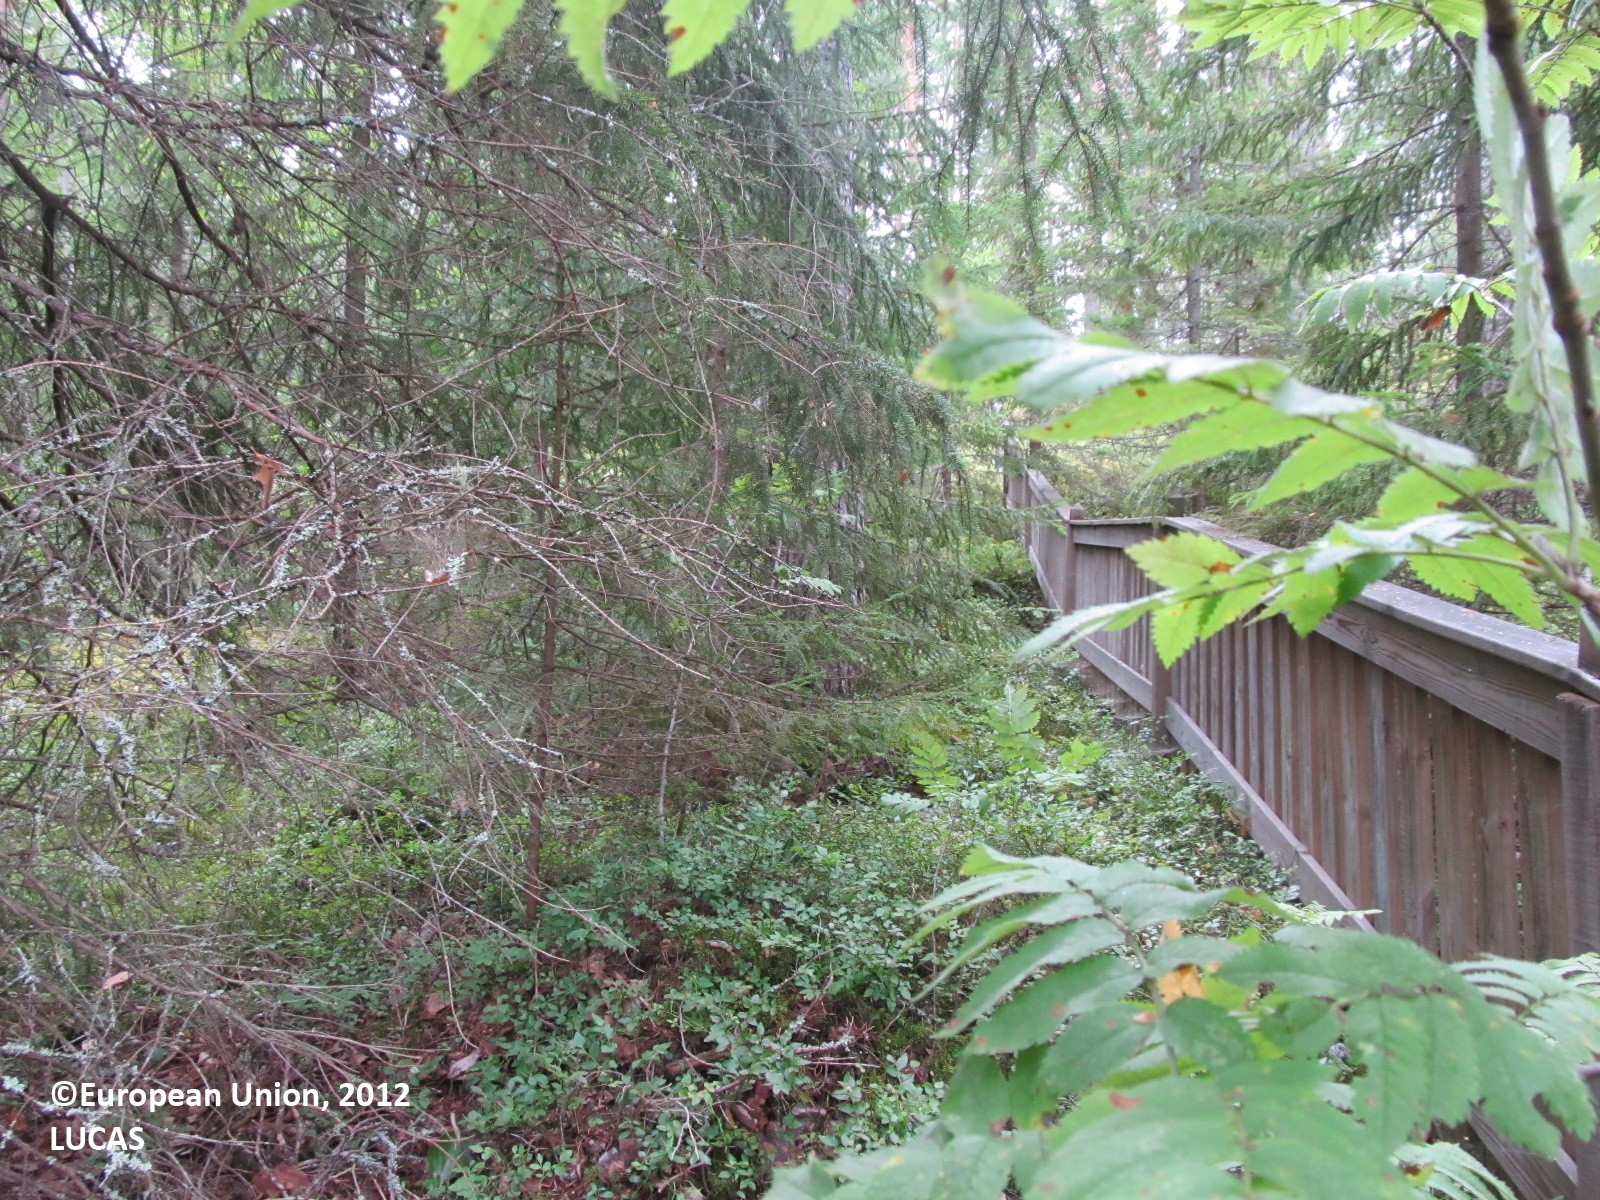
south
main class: Woodland
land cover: Spruce dominated mixed woodland
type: boreal forest
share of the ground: 25 - 50 %
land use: Forestry
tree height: > 5 m
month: August
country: FI
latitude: 62.1780
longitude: 28.0306
